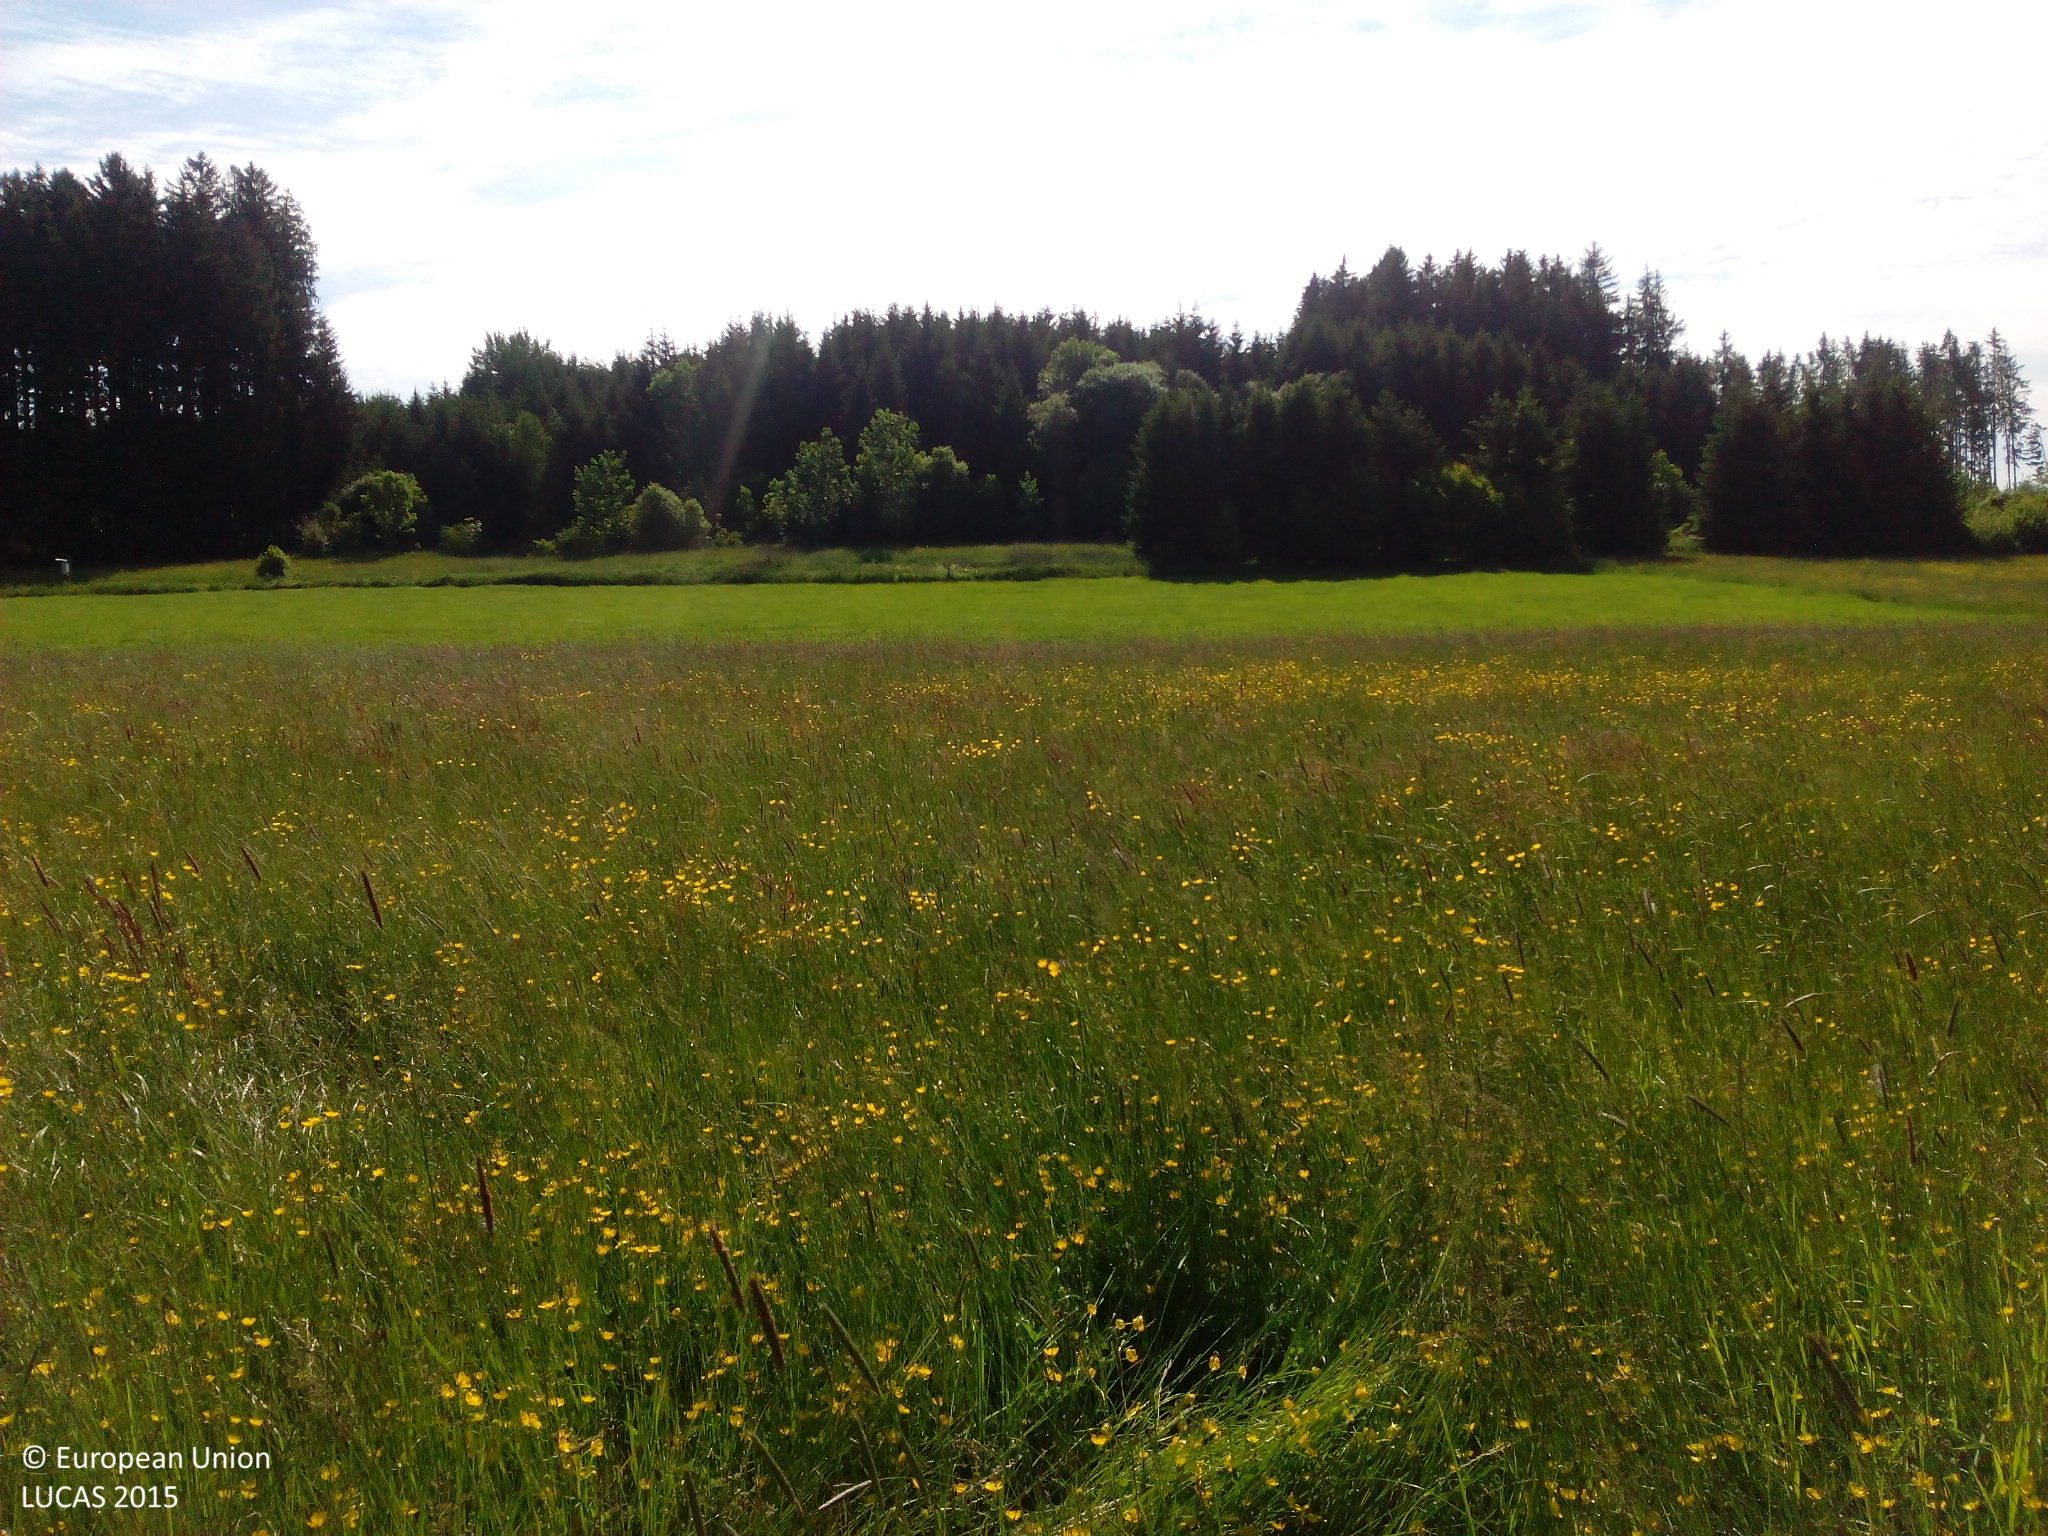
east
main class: Grassland
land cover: Grassland without tree/shrub cover
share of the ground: > 75 %
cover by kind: herbaceous plants 100 %
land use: Agriculture (excluding fallow land and kitchen gardens)
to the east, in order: Grassland without tree/shrub cover; Ditches and canals; Grassland without tree/shrub cover; Ditches and canals; Railways; Ditches and canals; Grassland without tree/shrub cover; Shrubland with sparse tree cover; Spruce dominated coniferous woodland
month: June
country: DE
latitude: 47.8453
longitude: 10.2537
